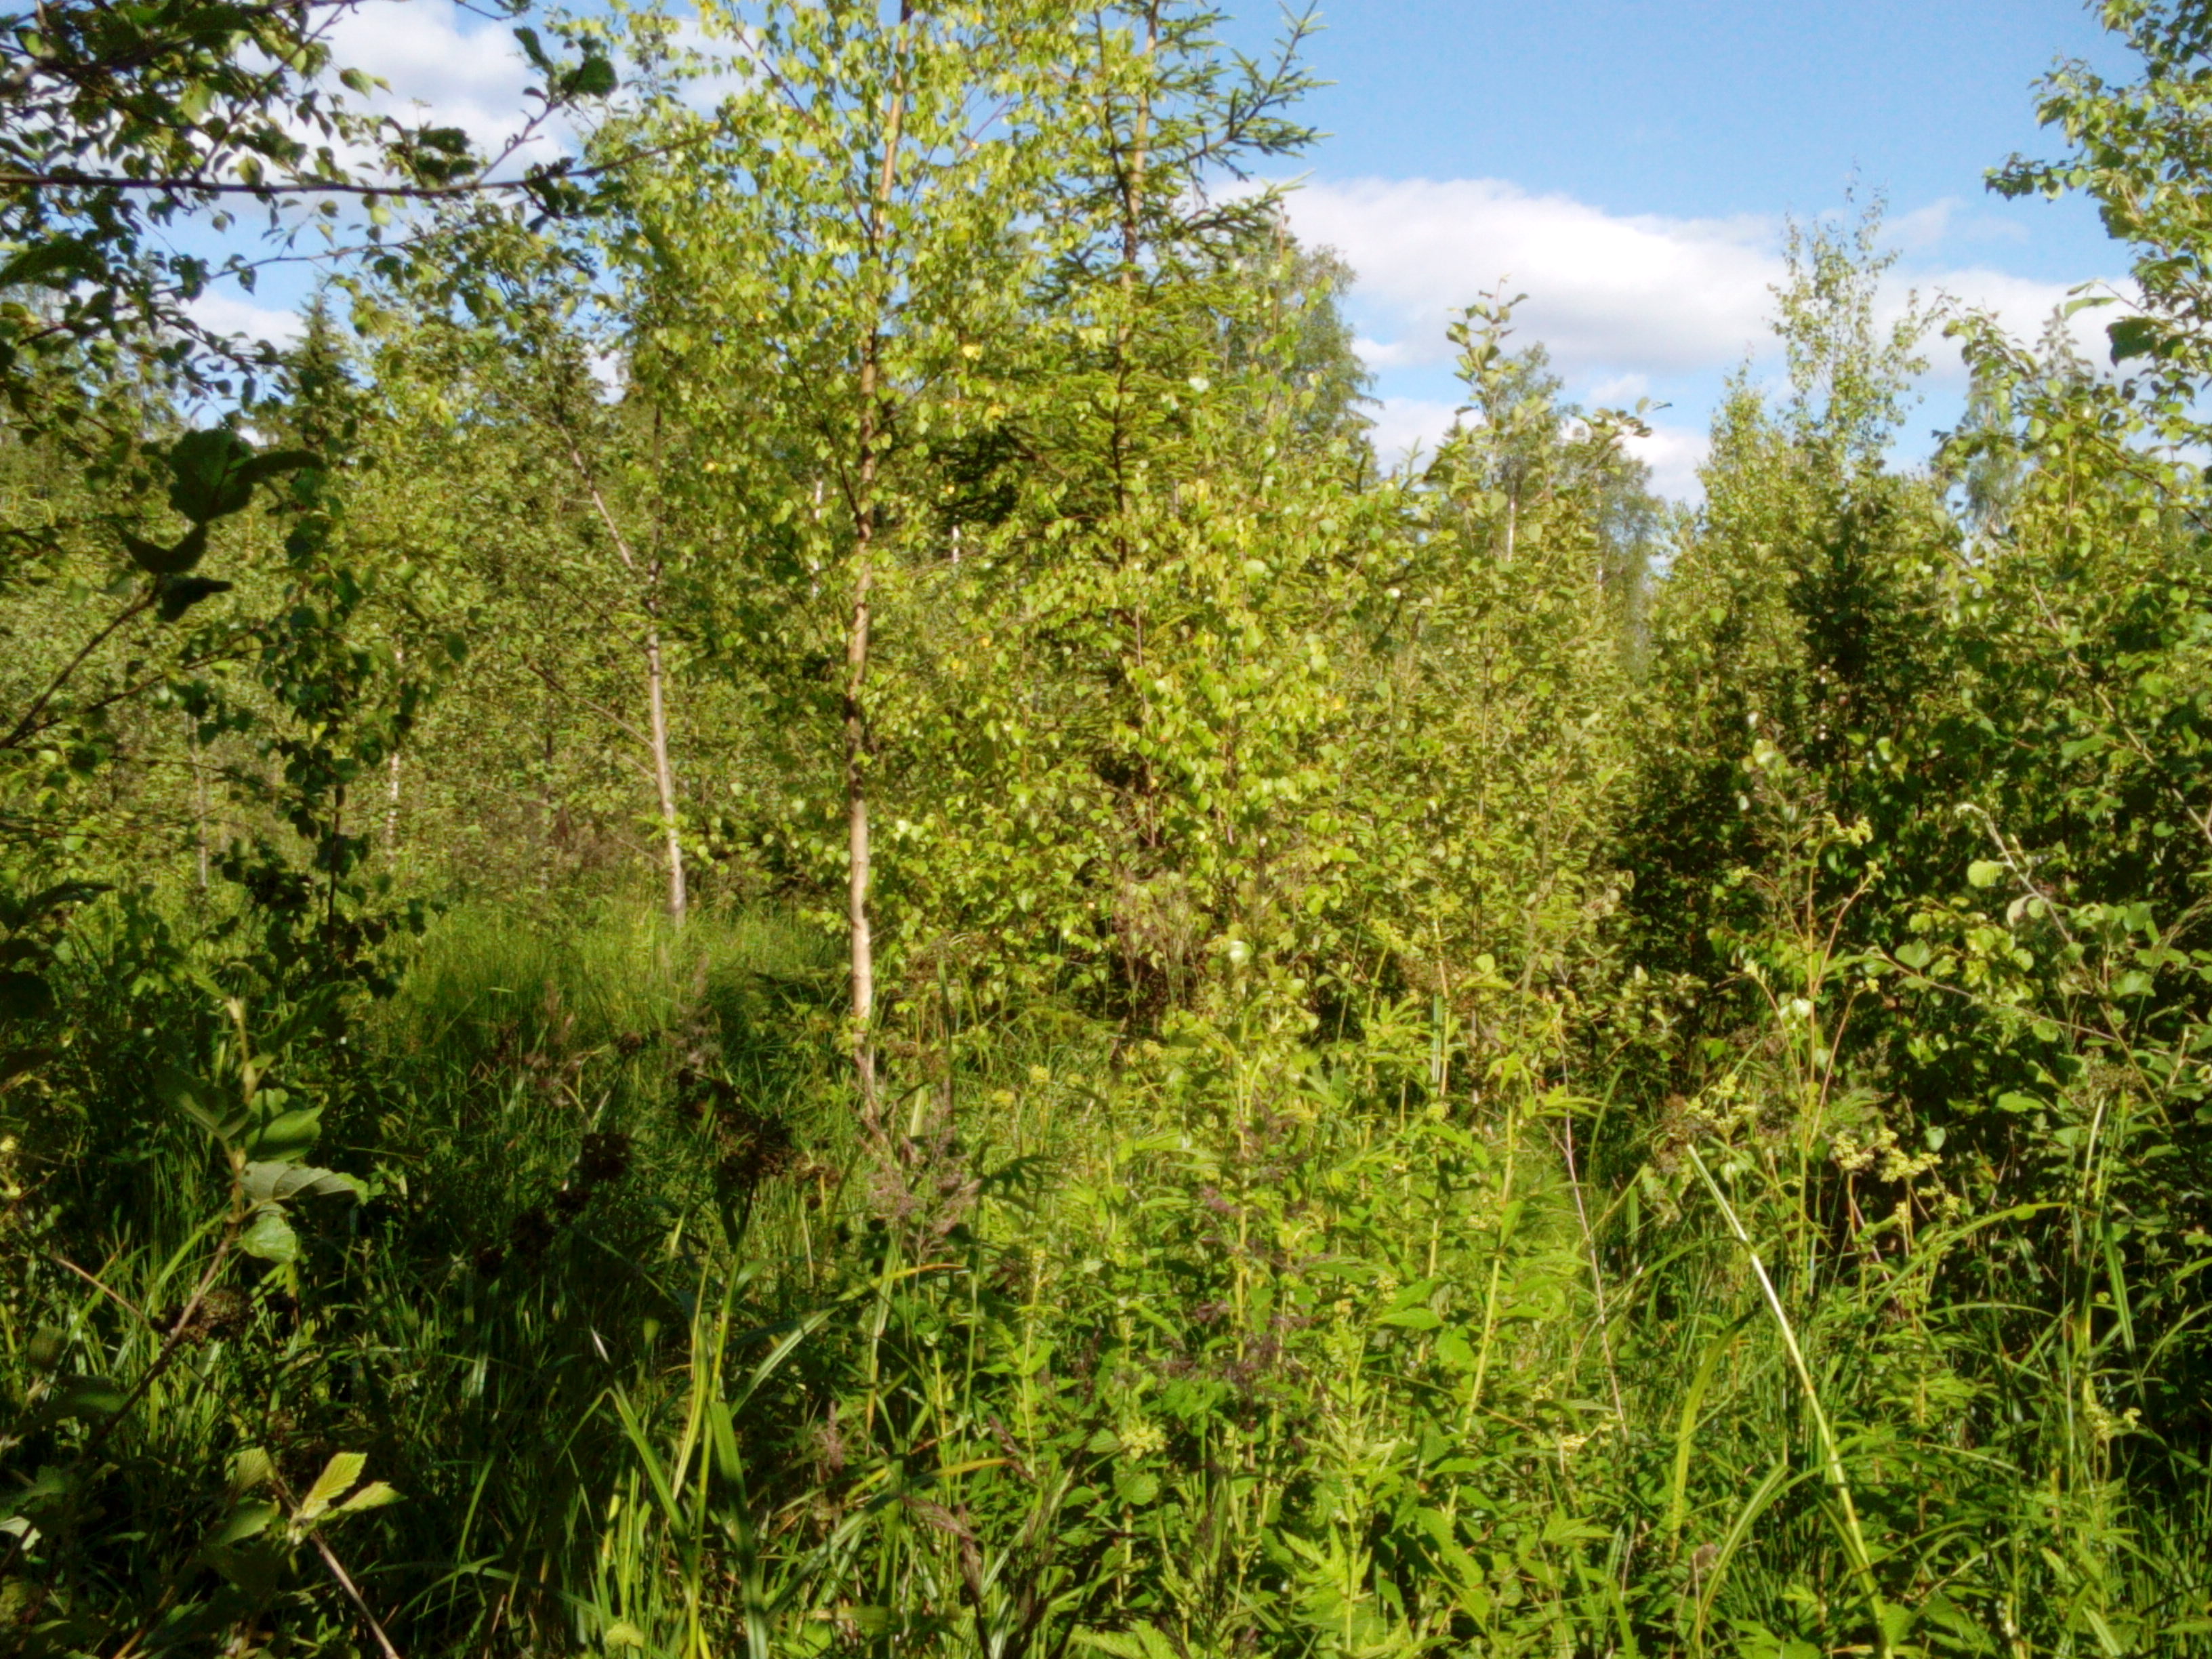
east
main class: Woodland
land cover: Broadleaved woodland
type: non-riverine alder, birch or aspen forest
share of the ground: > 75 %
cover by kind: broadleaved forest trees 75 %, herbaceous plants 15 %, coniferous forest trees 5 %, shrubs 5 %
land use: Forestry
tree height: < 5 m
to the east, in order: Broadleaved woodland; Spruce dominated mixed woodland; Broadleaved woodland
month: July
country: LV
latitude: 56.4909
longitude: 22.0527
